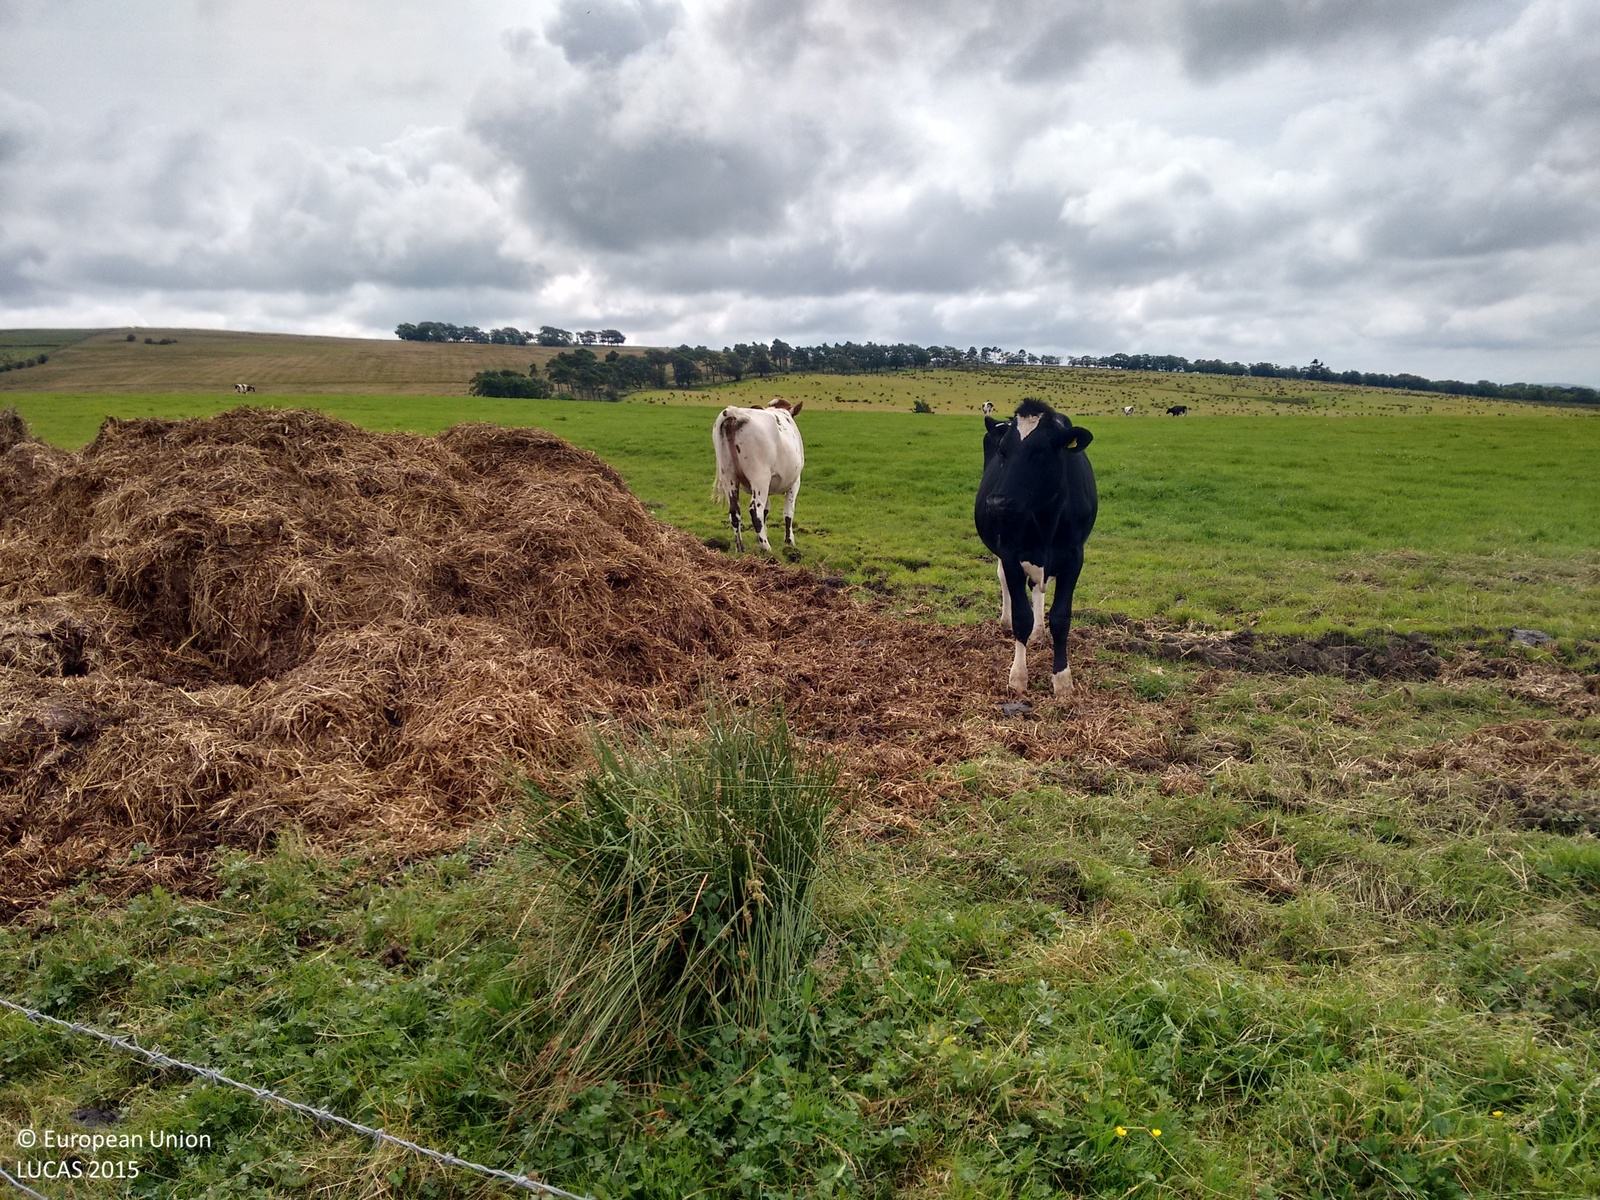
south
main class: Grassland
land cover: Grassland without tree/shrub cover
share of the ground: > 75 %
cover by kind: herbaceous plants 100 %
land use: Agriculture (excluding fallow land and kitchen gardens)
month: August
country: GB
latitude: 55.4460
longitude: -4.2113
